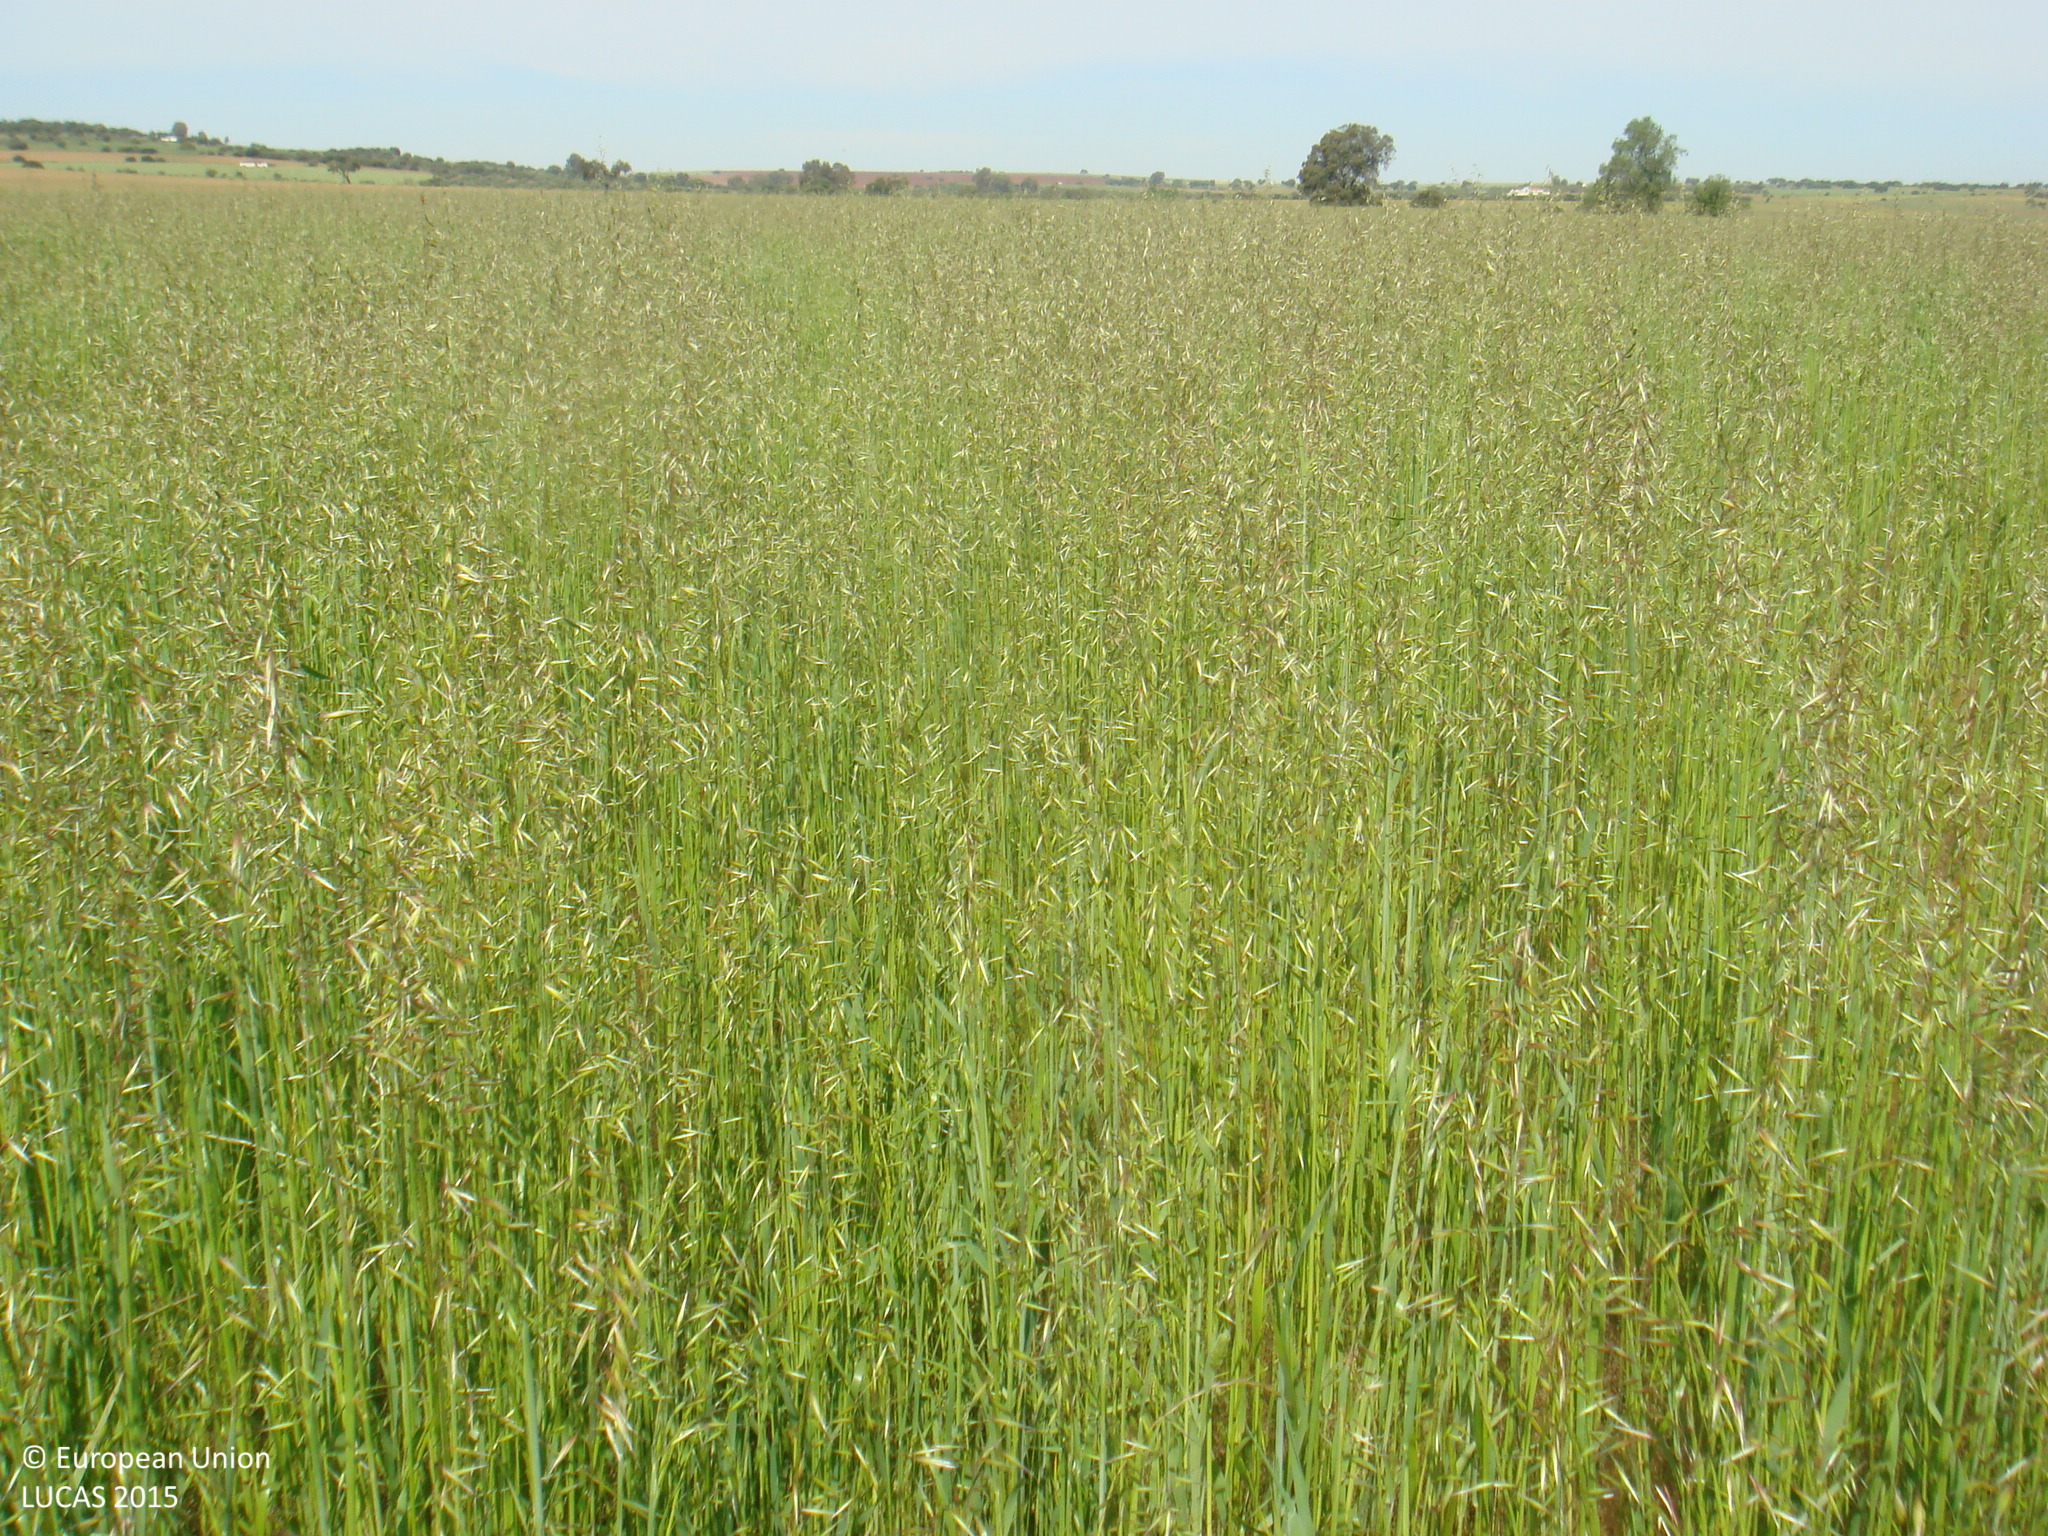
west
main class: Cropland
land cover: Oats
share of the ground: > 75 %
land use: Agriculture (excluding fallow land and kitchen gardens)
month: April
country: ES
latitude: 38.3271
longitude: -5.3934
